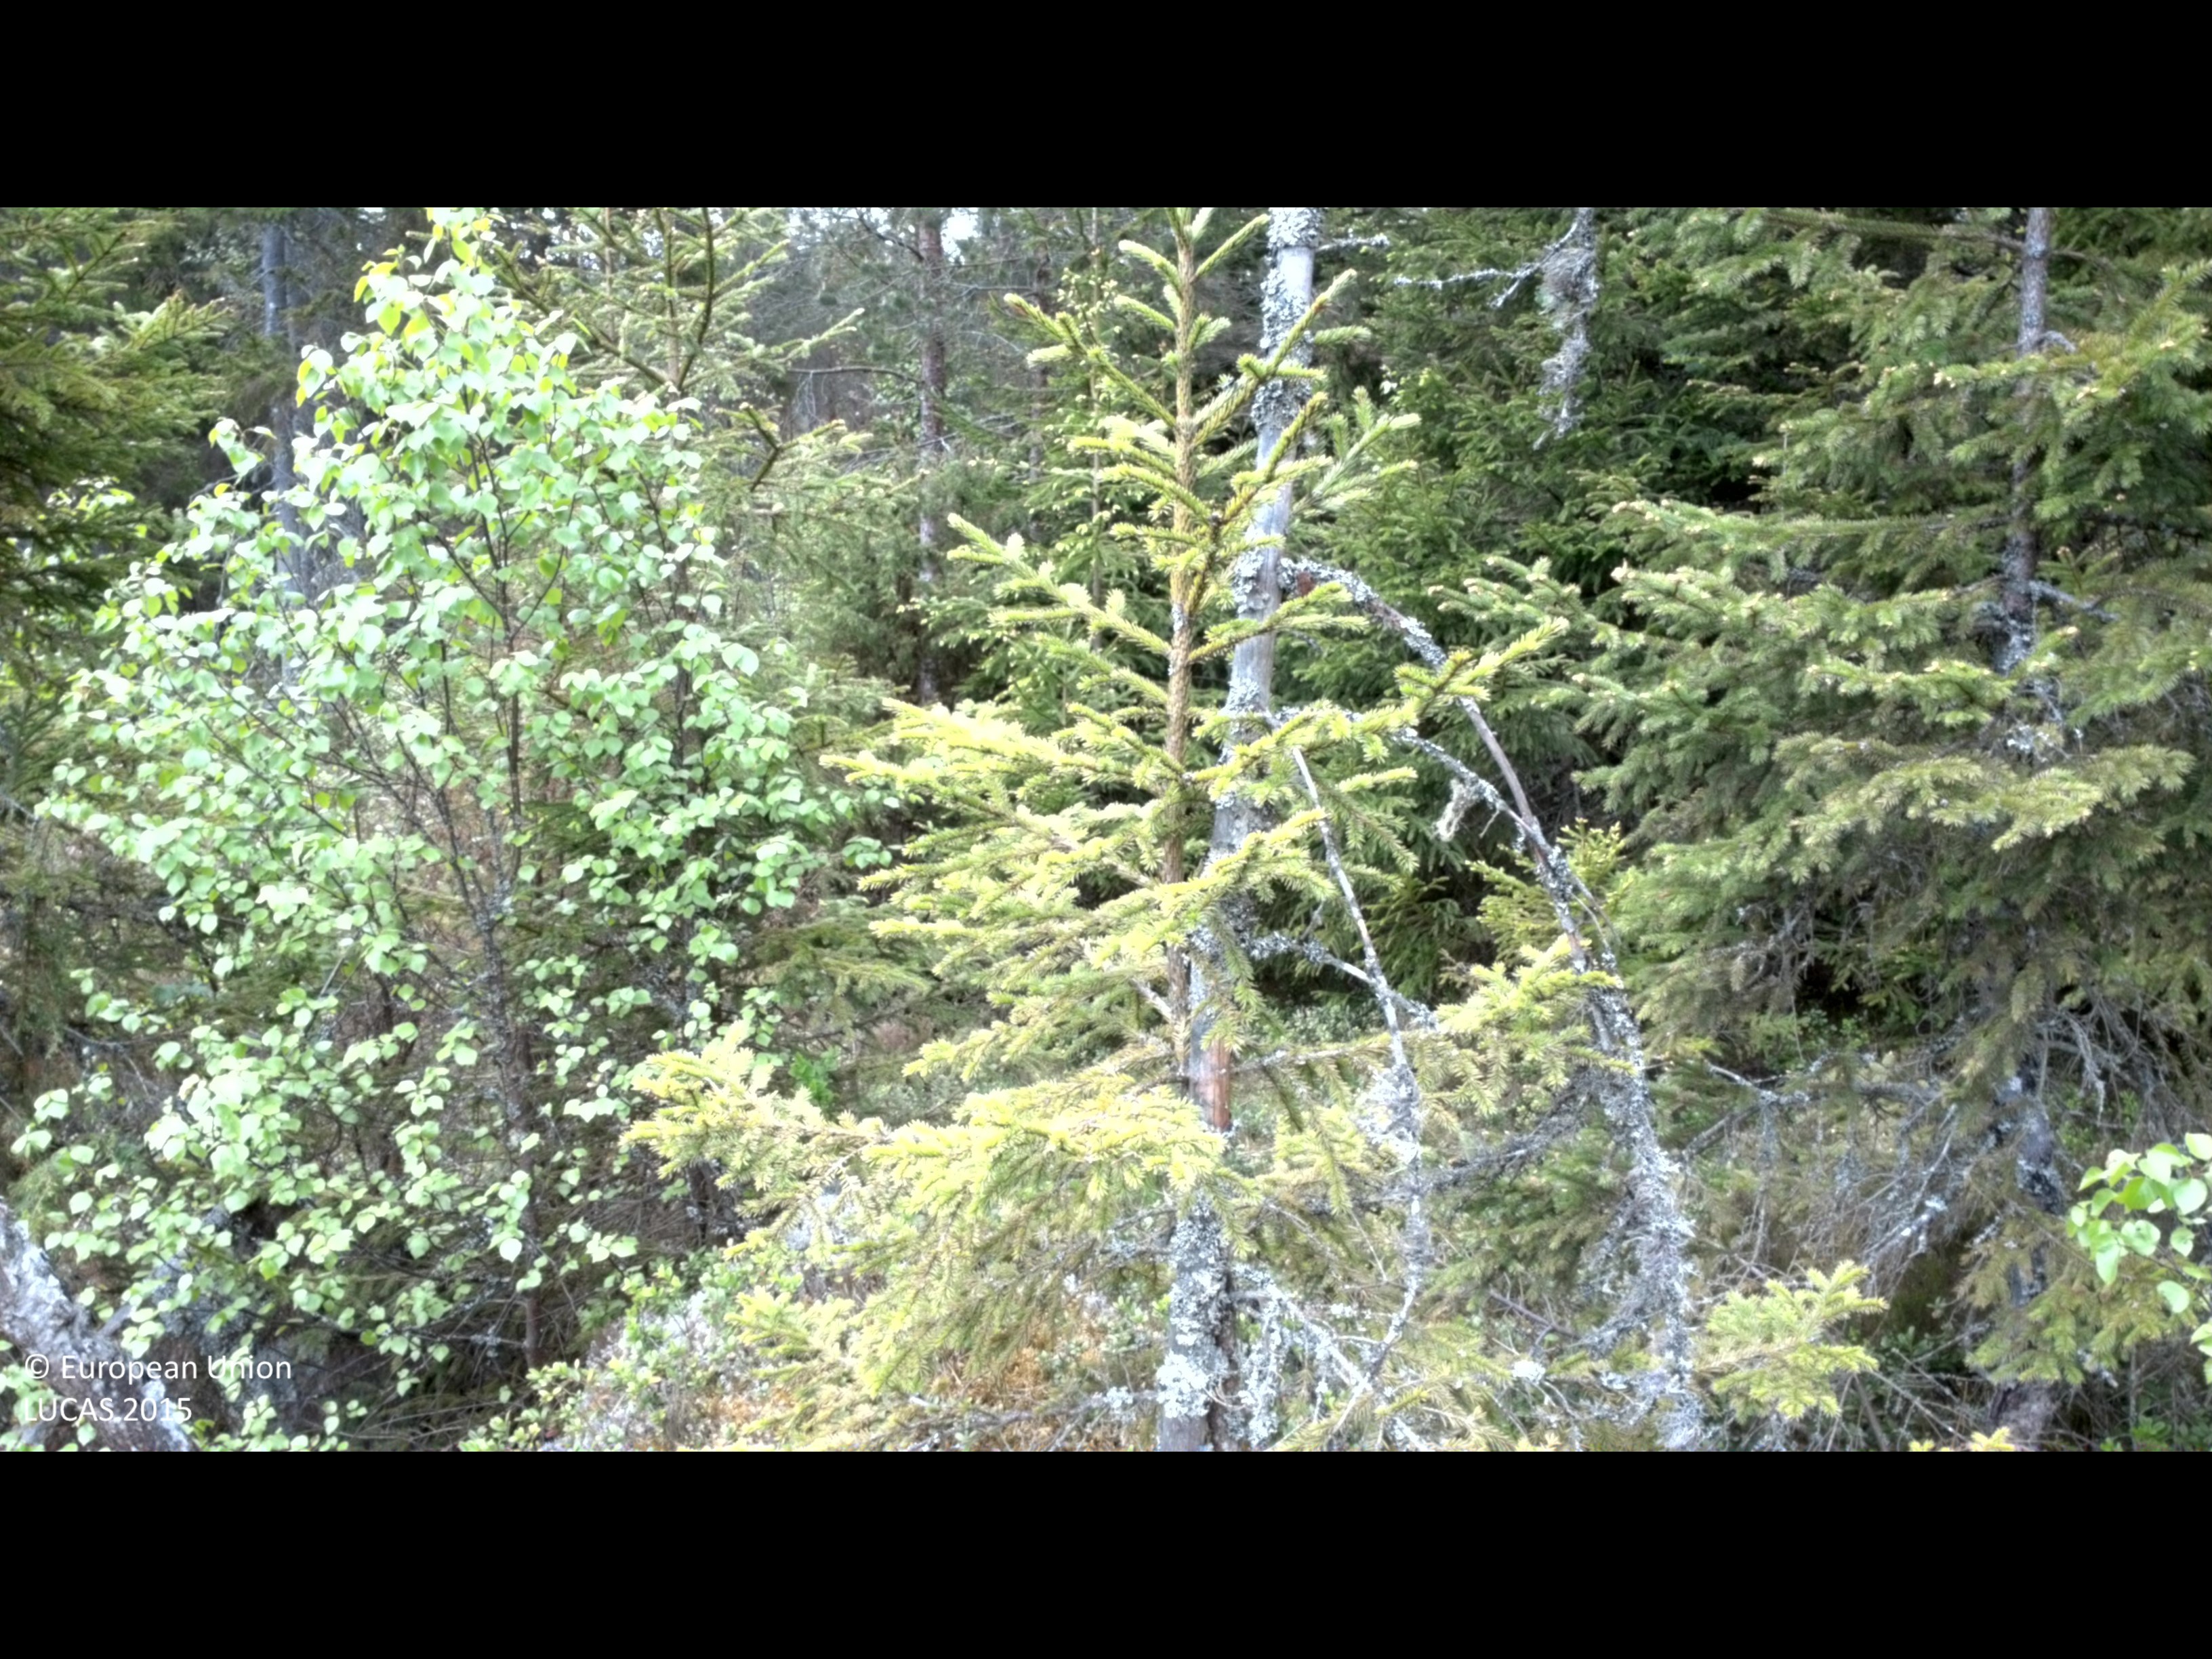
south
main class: Woodland
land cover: Spruce dominated coniferous woodland
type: boreal forest
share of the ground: > 75 %
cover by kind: coniferous forest trees 60 %, broadleaved forest trees 20 %, shrubs 20 %
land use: Forestry
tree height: < 5 m
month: May
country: SE
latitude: 57.4177
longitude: 16.0086
